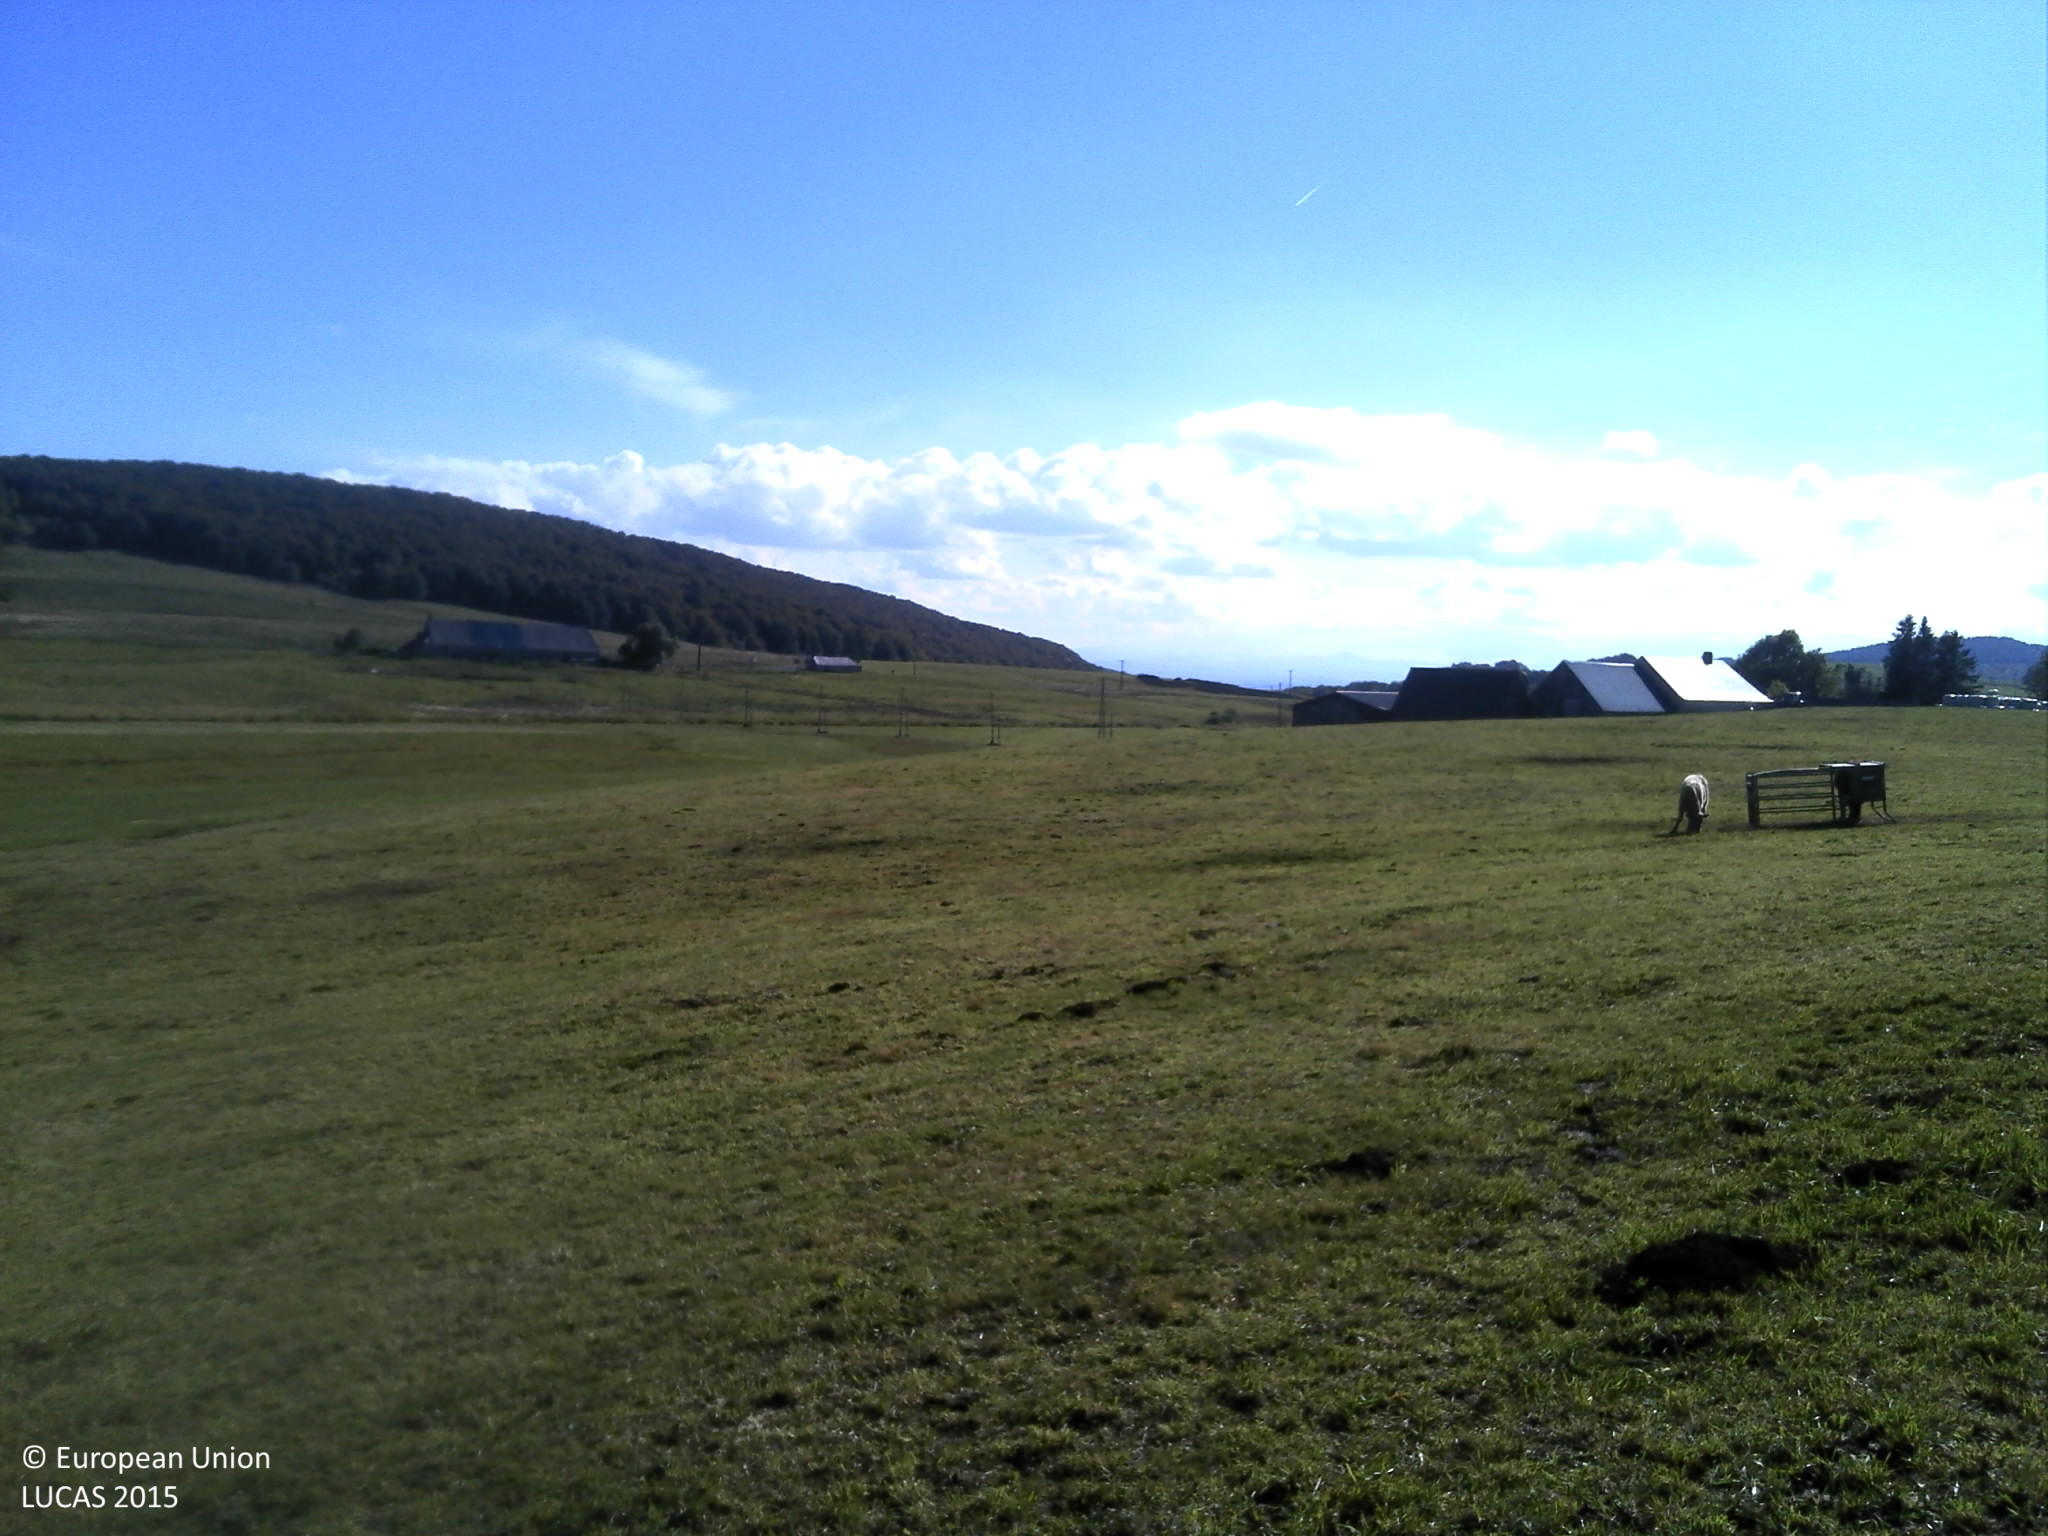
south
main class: Grassland
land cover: Grassland without tree/shrub cover
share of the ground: > 75 %
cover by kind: herbaceous plants 100 %
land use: Agriculture (excluding fallow land and kitchen gardens)
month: September
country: FR
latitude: 45.4788
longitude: 2.8487
